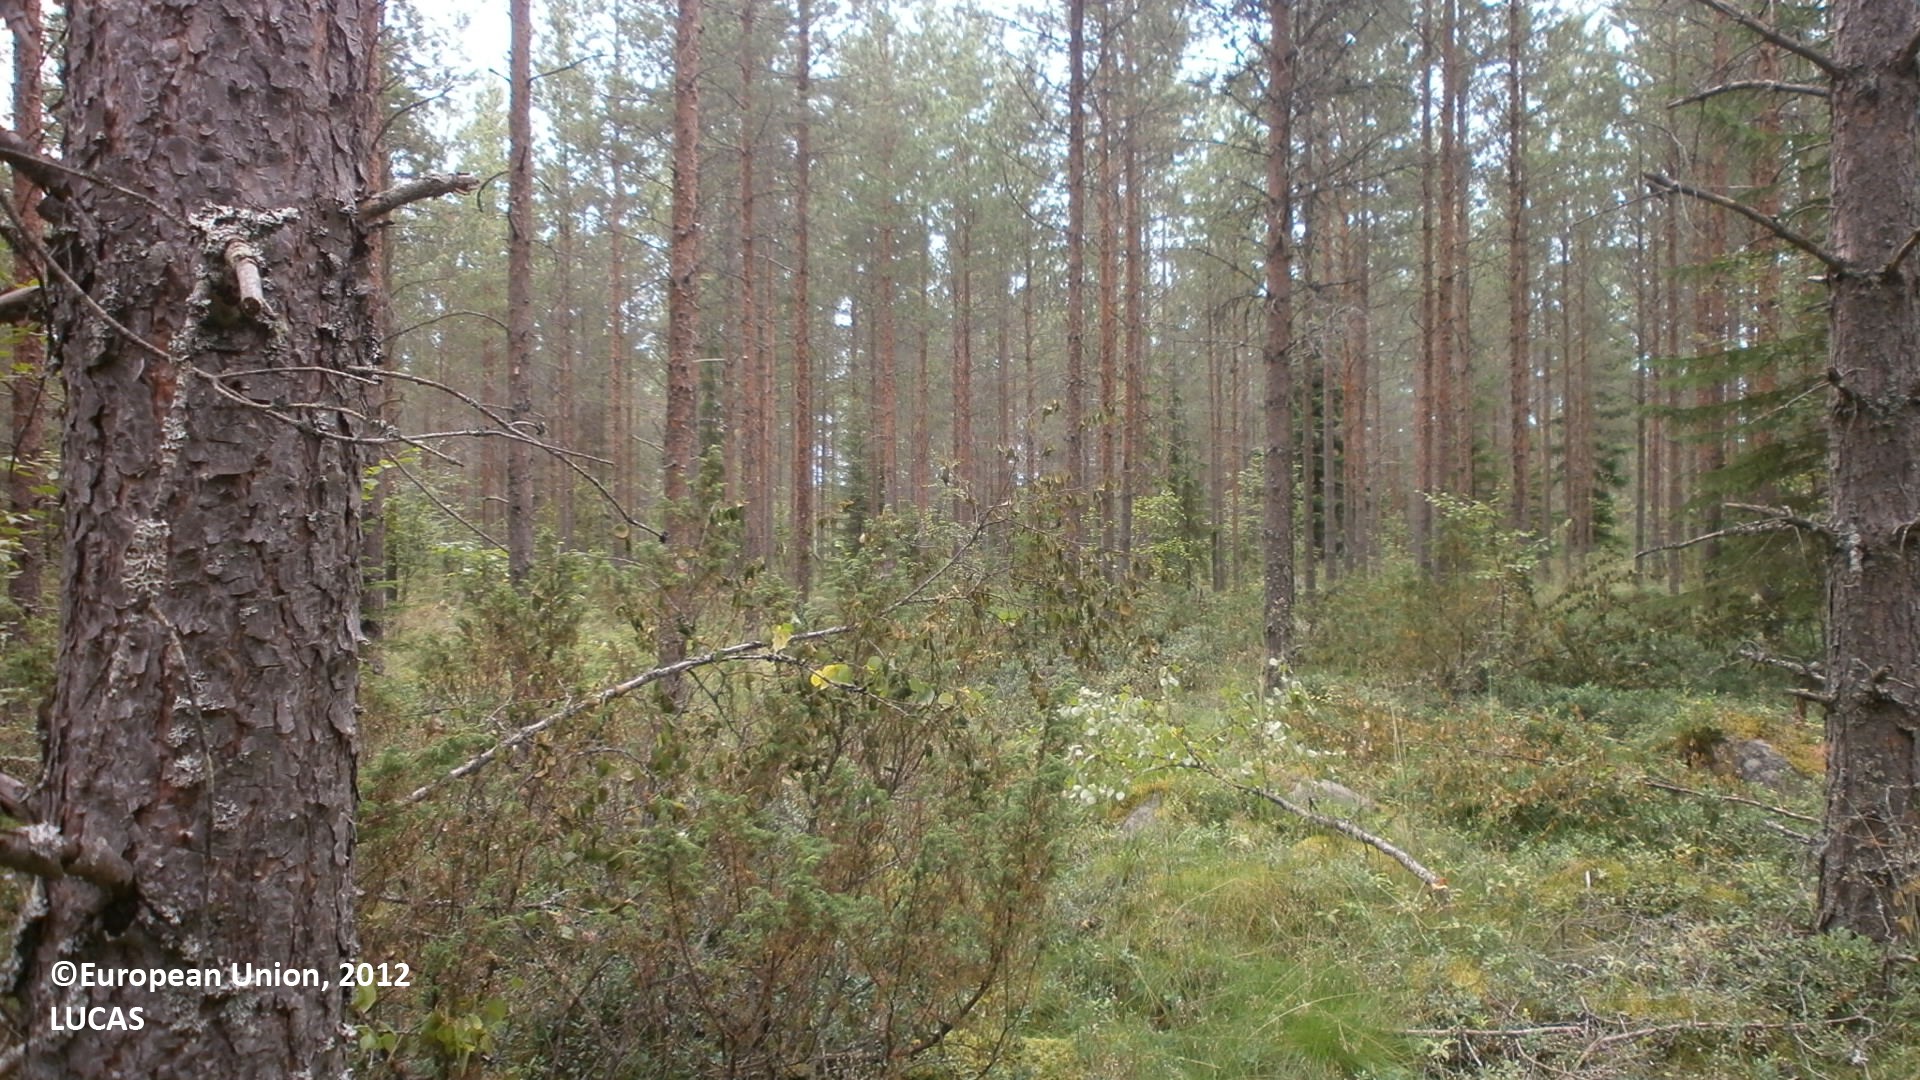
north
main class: Woodland
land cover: Pine dominated coniferous woodland
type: boreal forest
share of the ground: 50 - 75 %
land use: Forestry
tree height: > 5 m
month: July
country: FI
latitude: 64.0203
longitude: 23.9156
